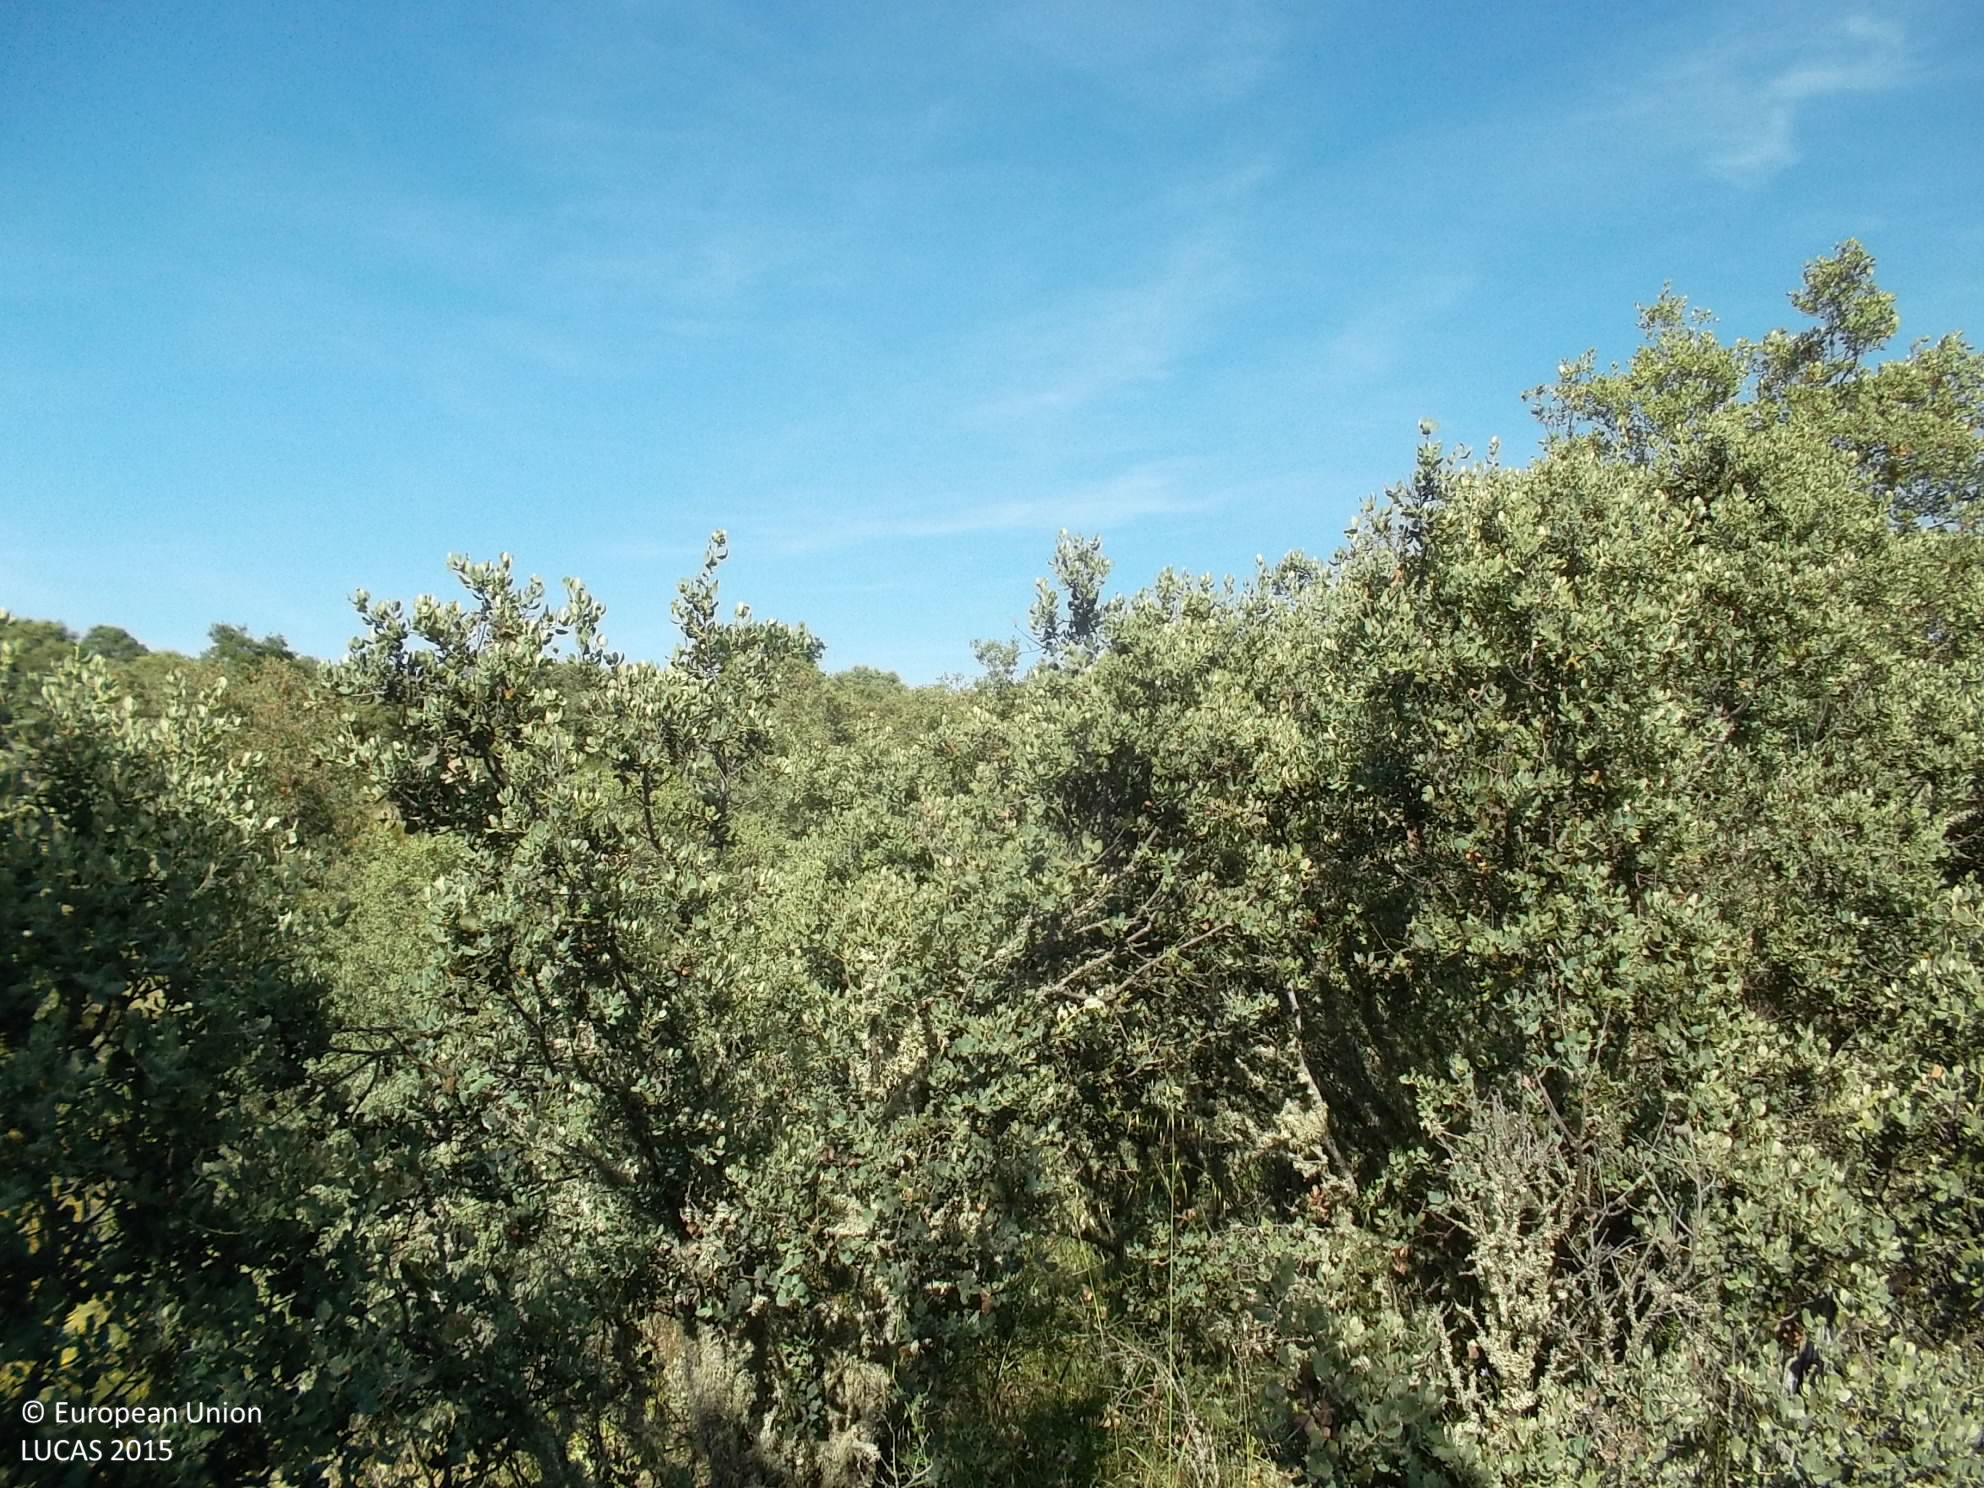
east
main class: Woodland
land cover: Broadleaved woodland
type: broadleaved evergreen forest
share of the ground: 25 - 50 %
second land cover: Shrubland without tree cover
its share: 50 - 75 %
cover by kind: broadleaved forest trees 40 %, shrubs 40 %, herbaceous plants 20 %
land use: Forestry
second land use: Agriculture (excluding fallow land and kitchen gardens)
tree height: < 5 m
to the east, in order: Broadleaved woodland; Shrubland without tree cover; Rock outcrops; Broadleaved woodland; Rivers and streams; Broadleaved woodland; Rock outcrops; Broadleaved woodland
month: May
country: ES
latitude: 38.7773
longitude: -4.5171
